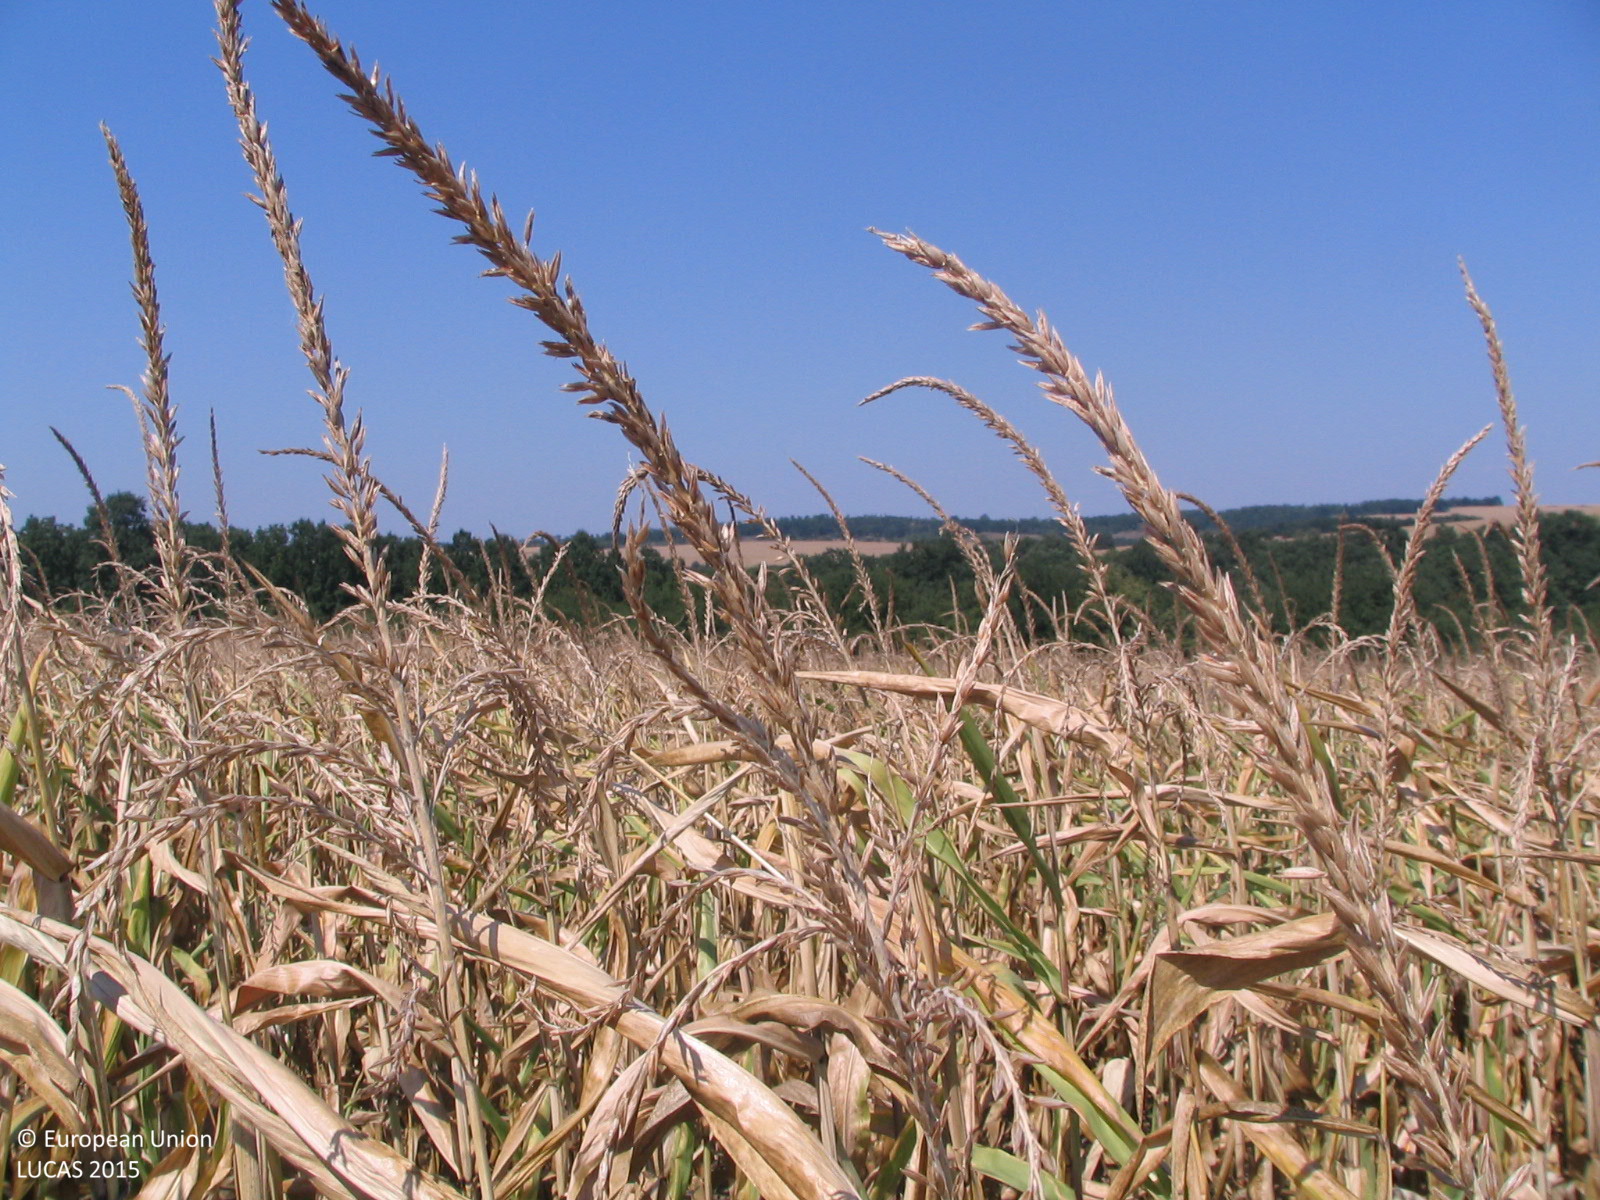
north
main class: Cropland
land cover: Maize
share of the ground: > 75 %
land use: Agriculture (excluding fallow land and kitchen gardens)
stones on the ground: < 10 %
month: August
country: BG
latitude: 43.1878
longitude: 24.4411
